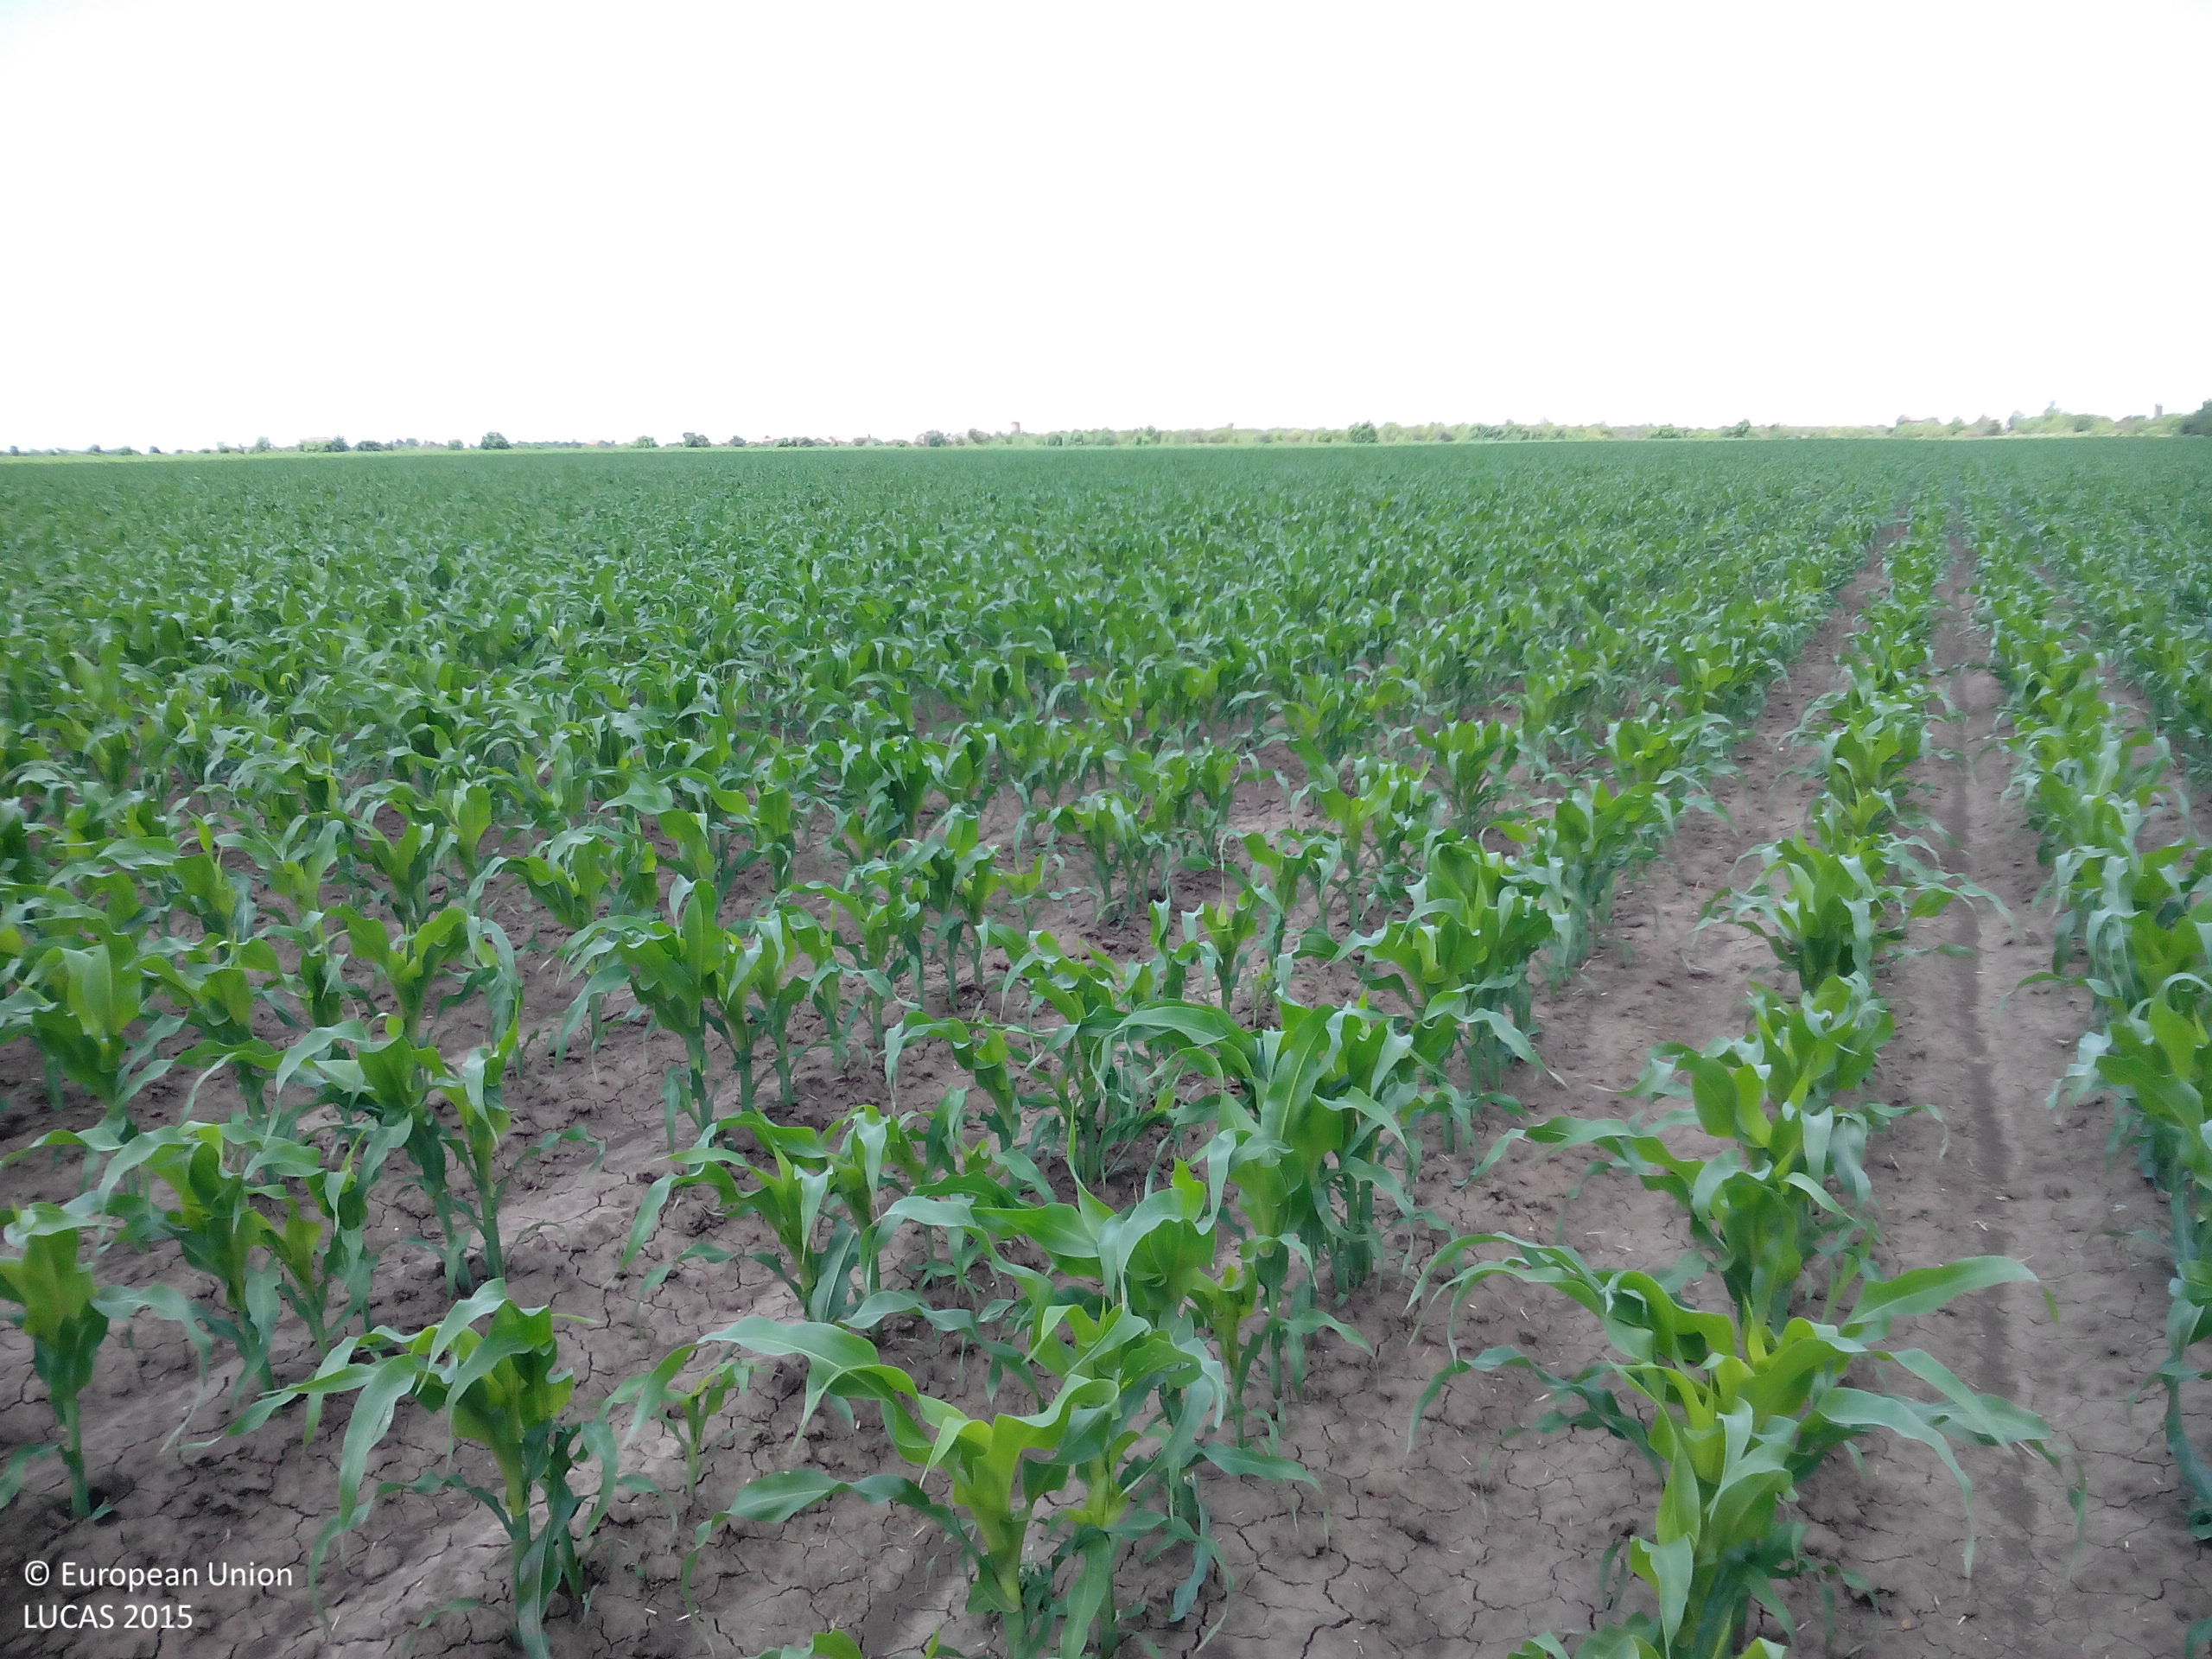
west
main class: Cropland
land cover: Maize
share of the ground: 50 - 75 %
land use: Agriculture (excluding fallow land and kitchen gardens)
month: May
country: BG
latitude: 43.4900
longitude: 24.1141
